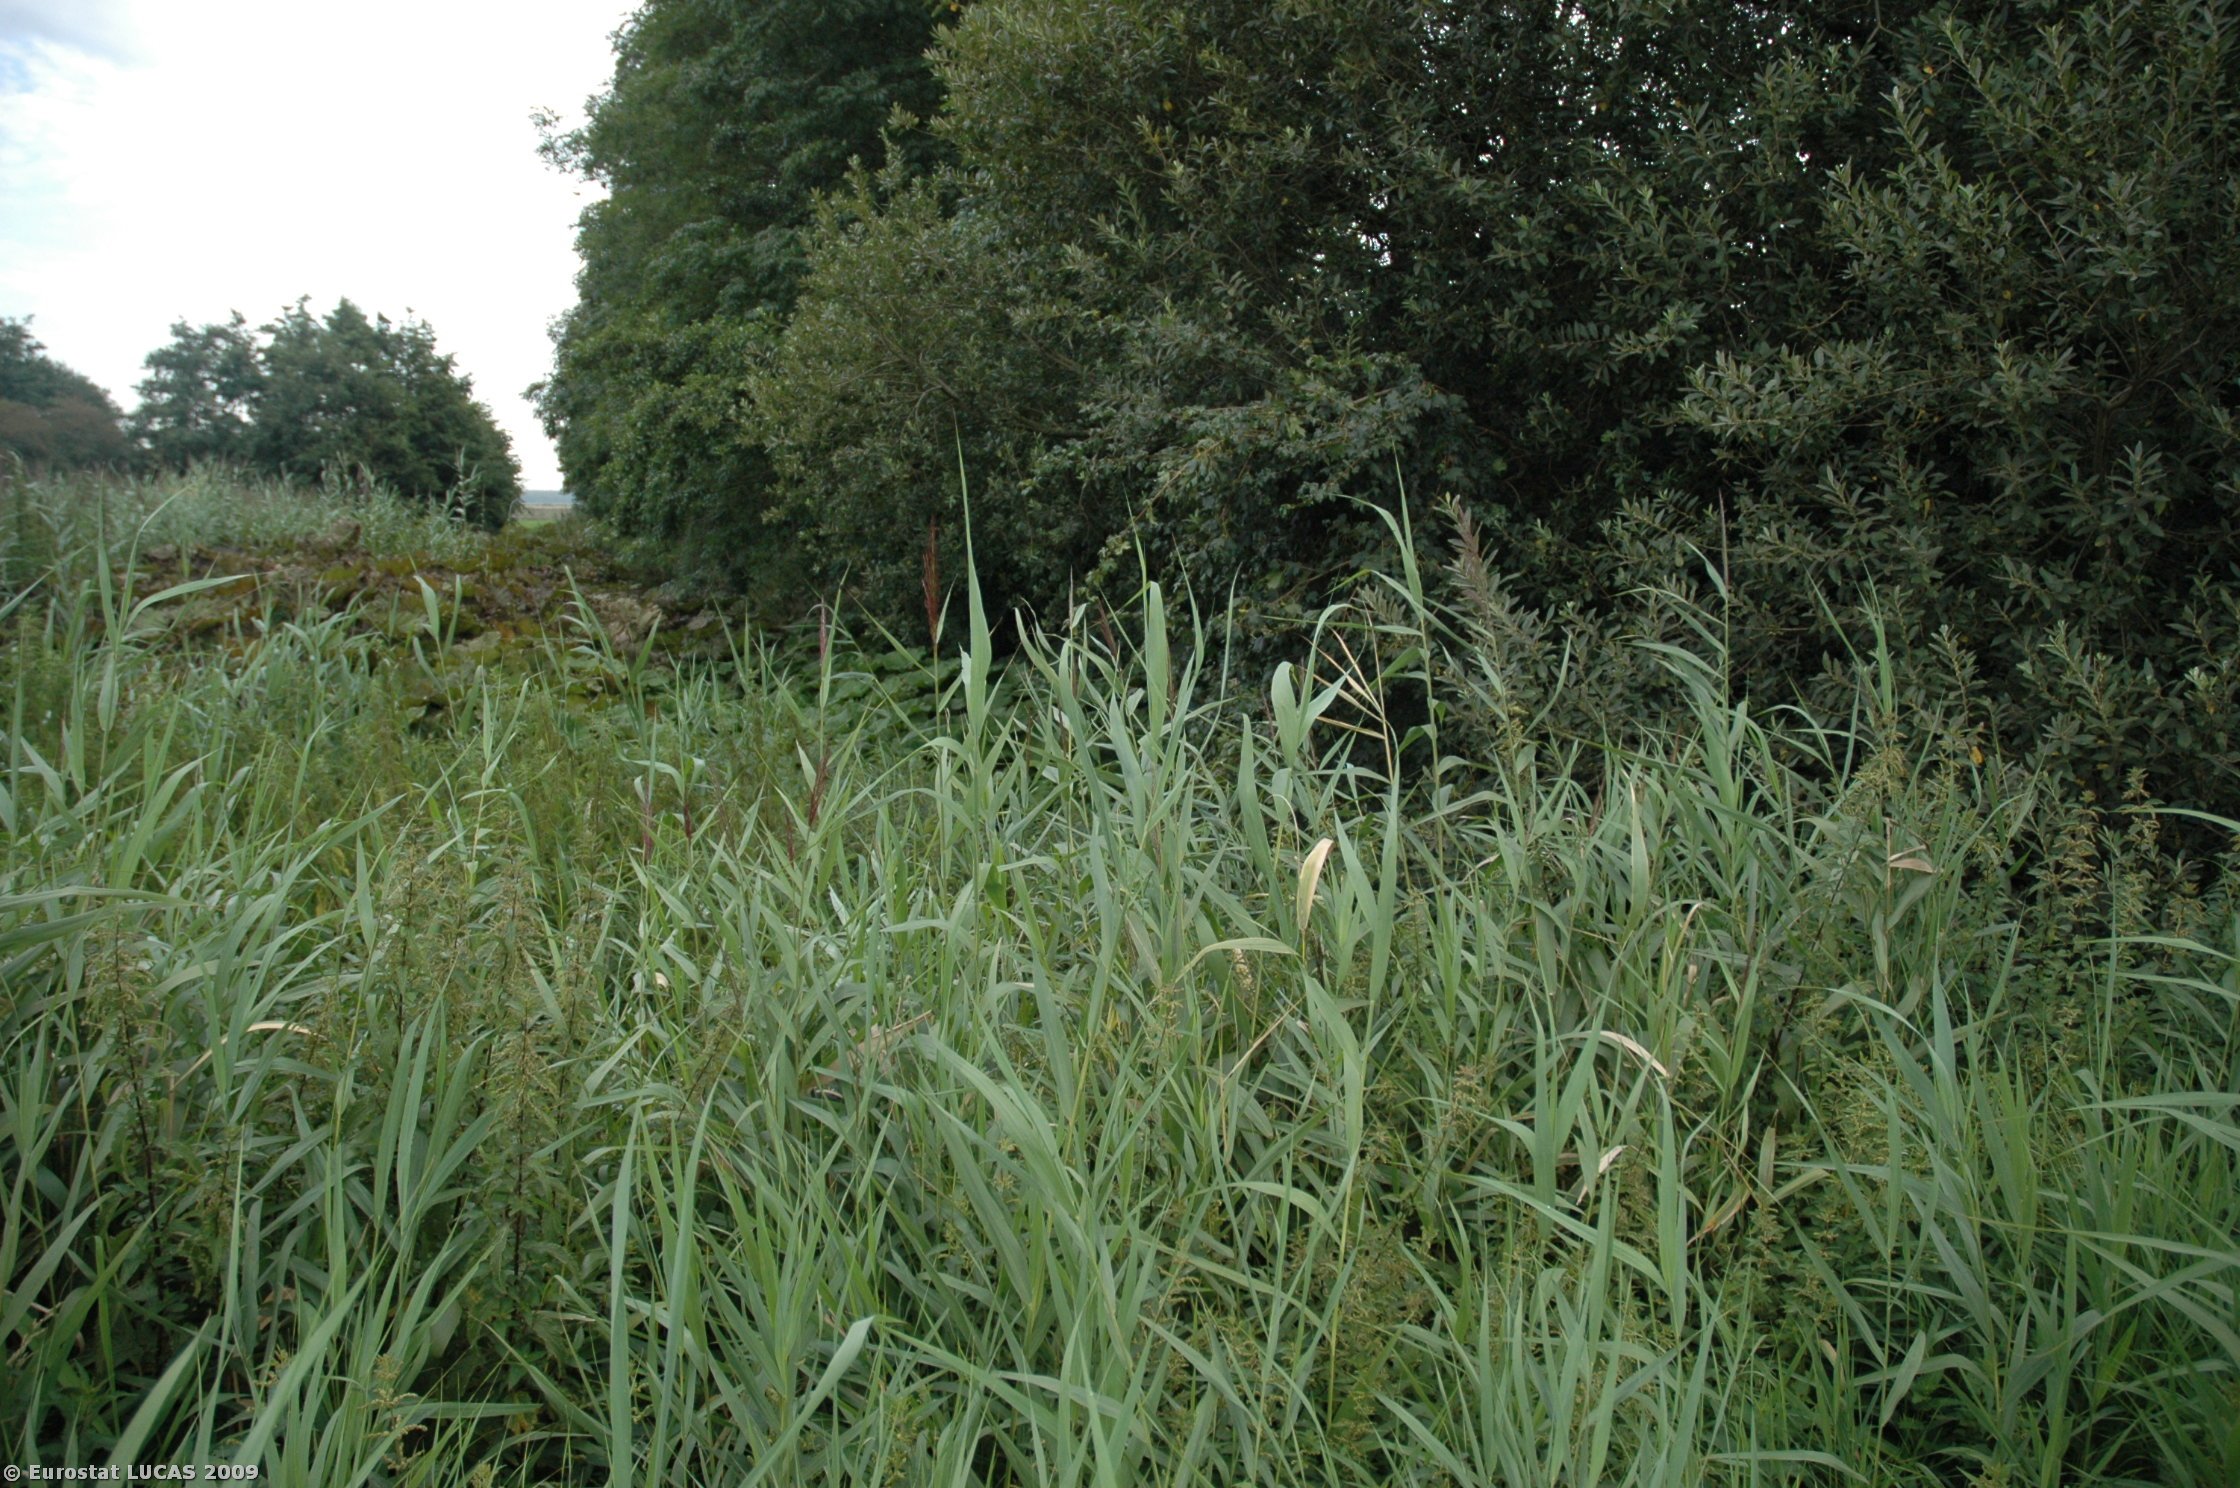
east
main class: Grassland
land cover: Grassland without tree/shrub cover
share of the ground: > 75 %
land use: Agriculture (excluding fallow land and kitchen gardens)
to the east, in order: Grassland without tree/shrub cover; Broadleaved woodland; Grassland without tree/shrub cover; Tracks; Grassland without tree/shrub cover
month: August
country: NL
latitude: 52.3055
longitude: 5.3783
